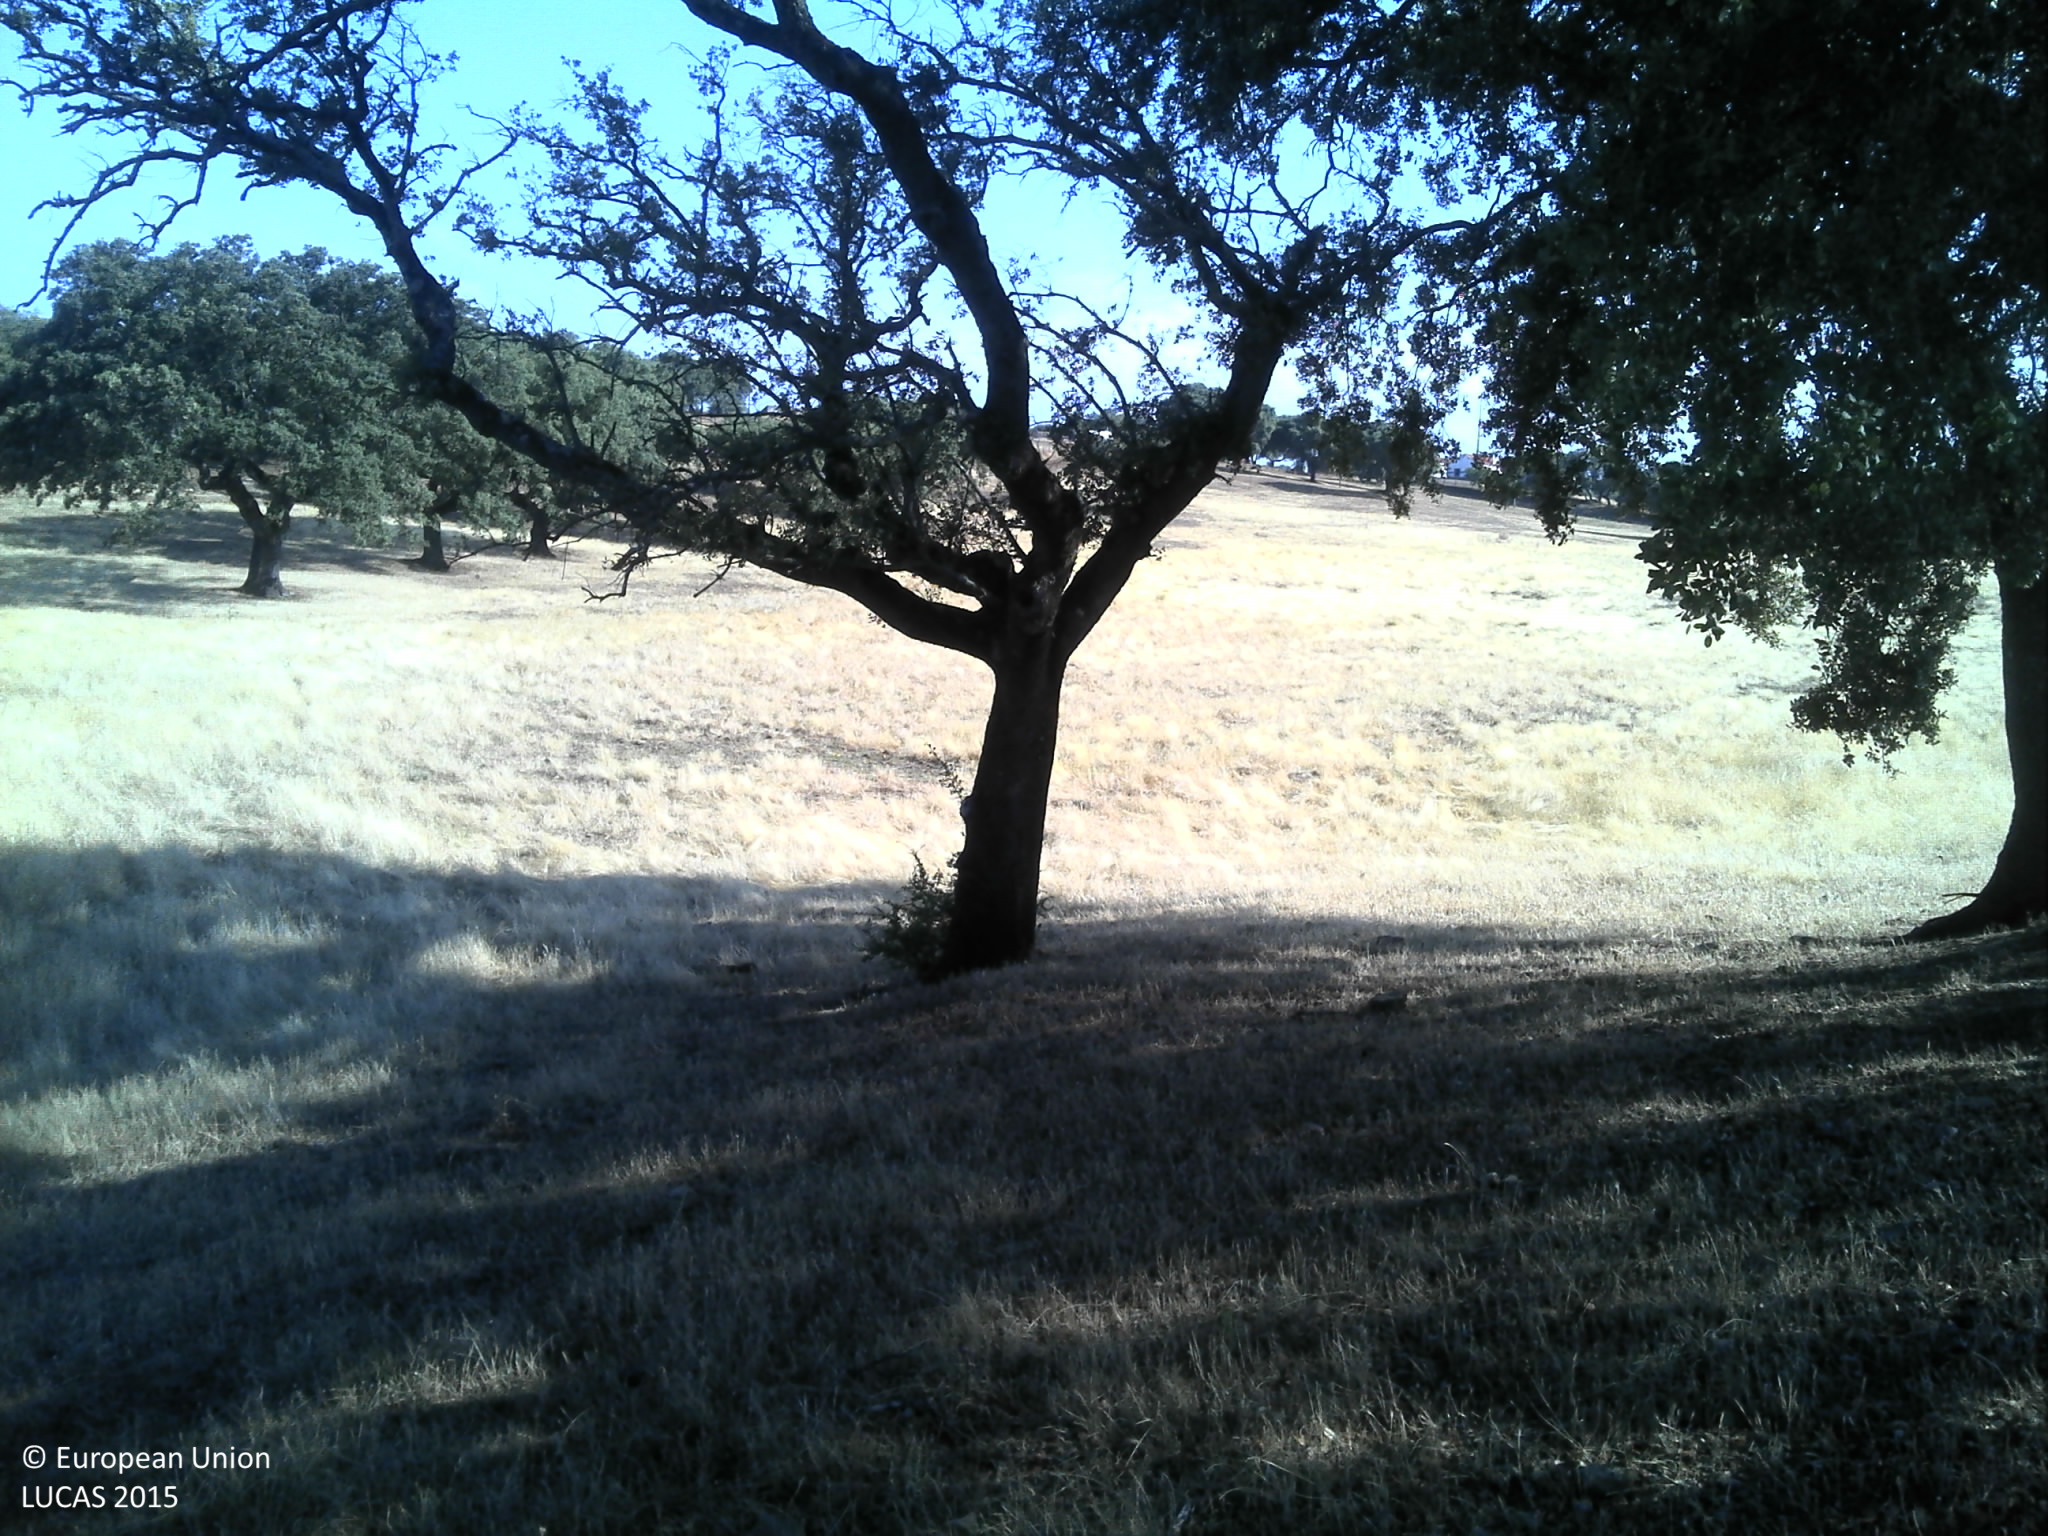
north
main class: Grassland
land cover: Grassland with sparse tree/shrub cover
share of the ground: 25 - 50 %
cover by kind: herbaceous plants 60 %, unconsolidated bare surface 30 %, broadleaved forest trees 5 %
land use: Agriculture (excluding fallow land and kitchen gardens)
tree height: > 5 m
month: June
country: PT
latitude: 40.0132
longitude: -7.0681
